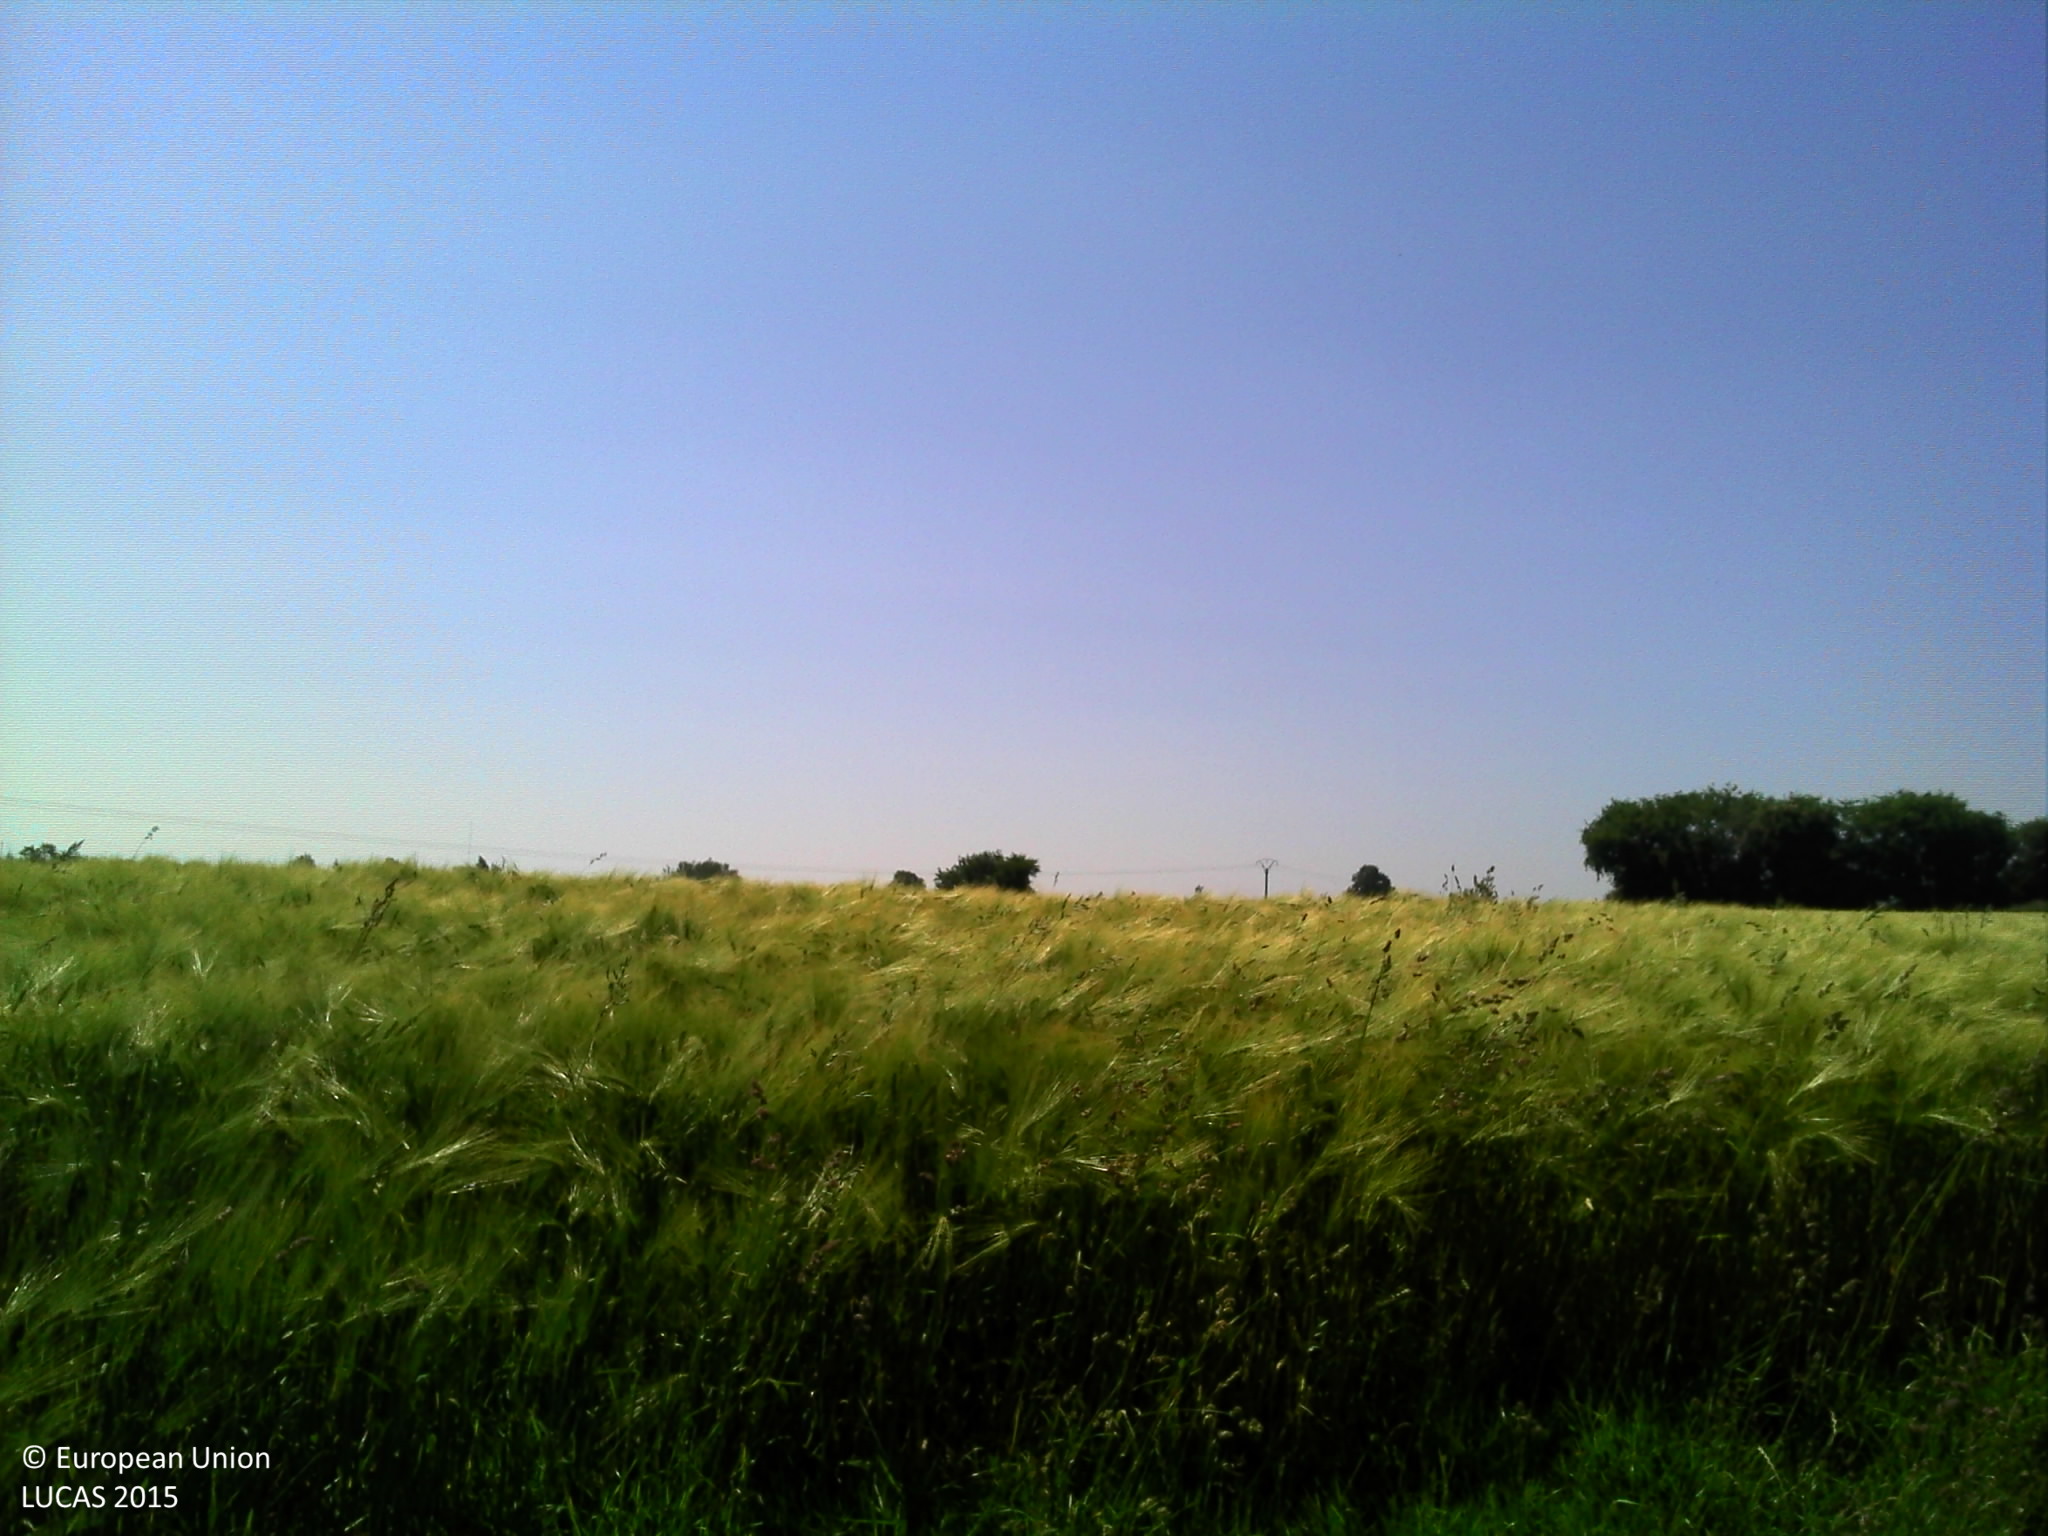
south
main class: Cropland
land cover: Barley
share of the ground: > 75 %
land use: Agriculture (excluding fallow land and kitchen gardens)
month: June
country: FR
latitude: 48.1471
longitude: -0.0151
